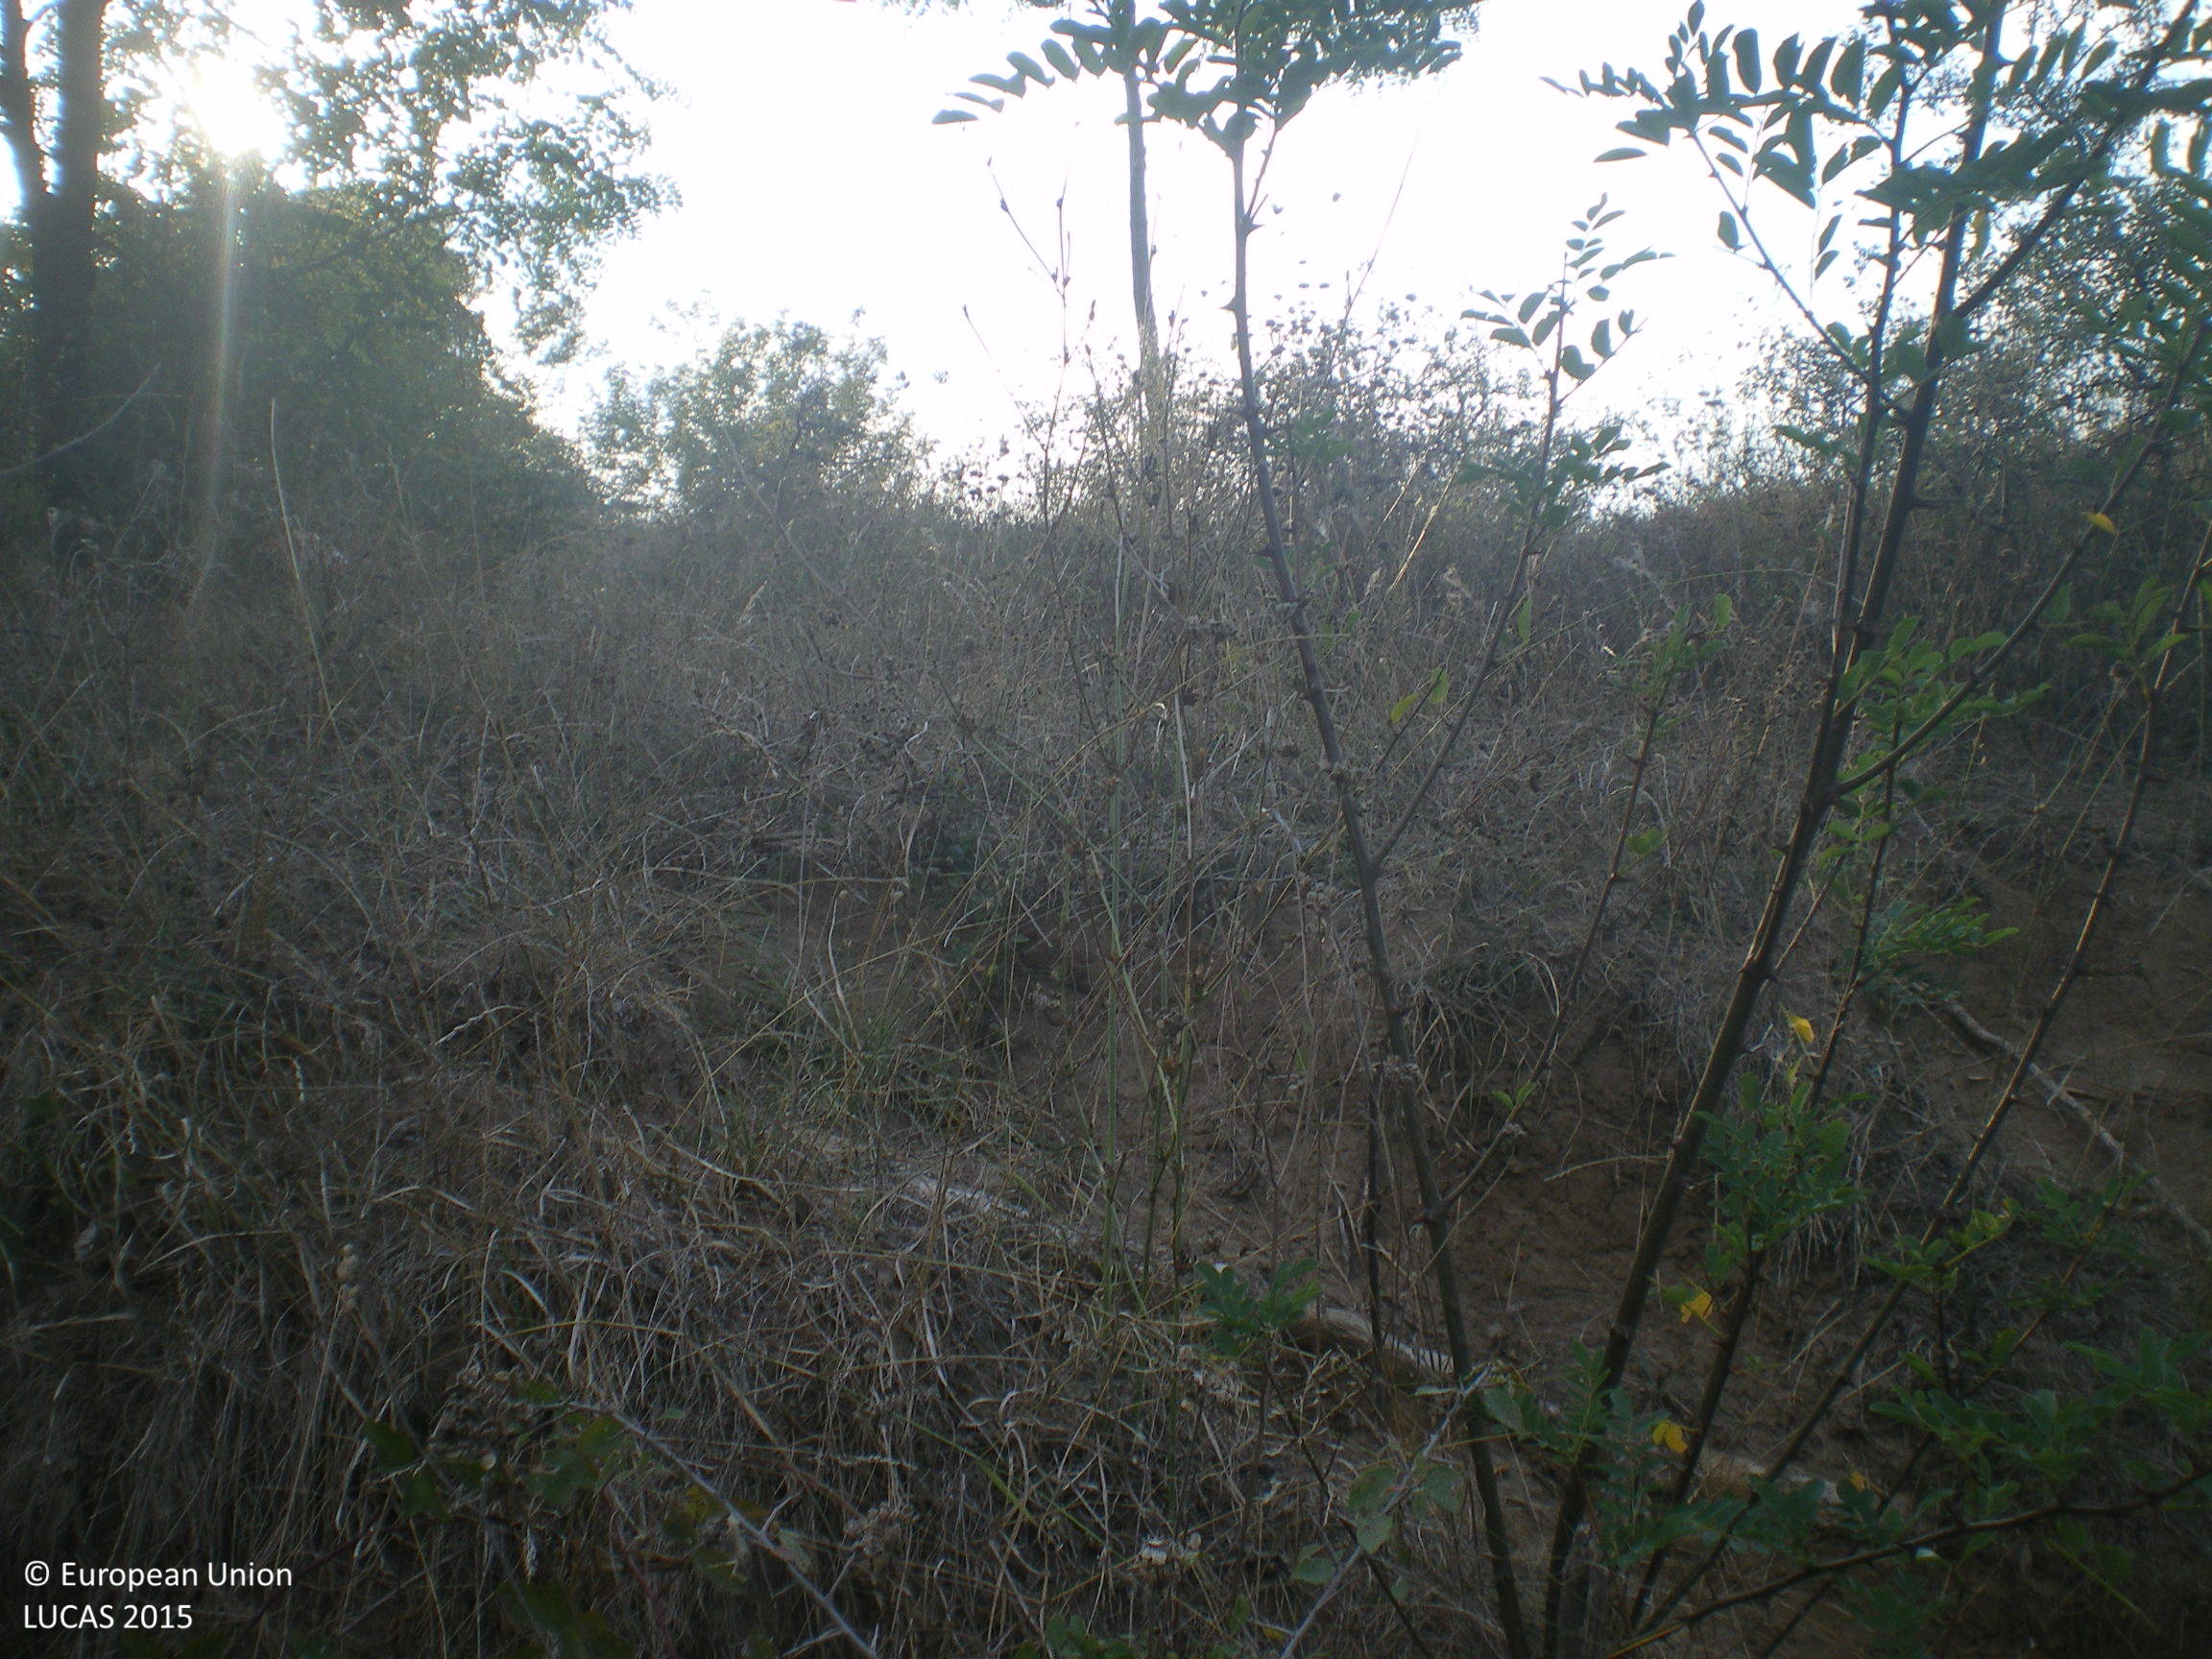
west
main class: Woodland
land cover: Broadleaved woodland
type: mesophytic deciduous forest
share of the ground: 50 - 75 %
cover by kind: broadleaved forest trees 50 %, herbaceous plants 45 %, shrubs 5 %
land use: Agriculture (excluding fallow land and kitchen gardens)
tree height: > 5 m
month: September
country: BG
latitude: 42.1094
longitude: 26.1020
